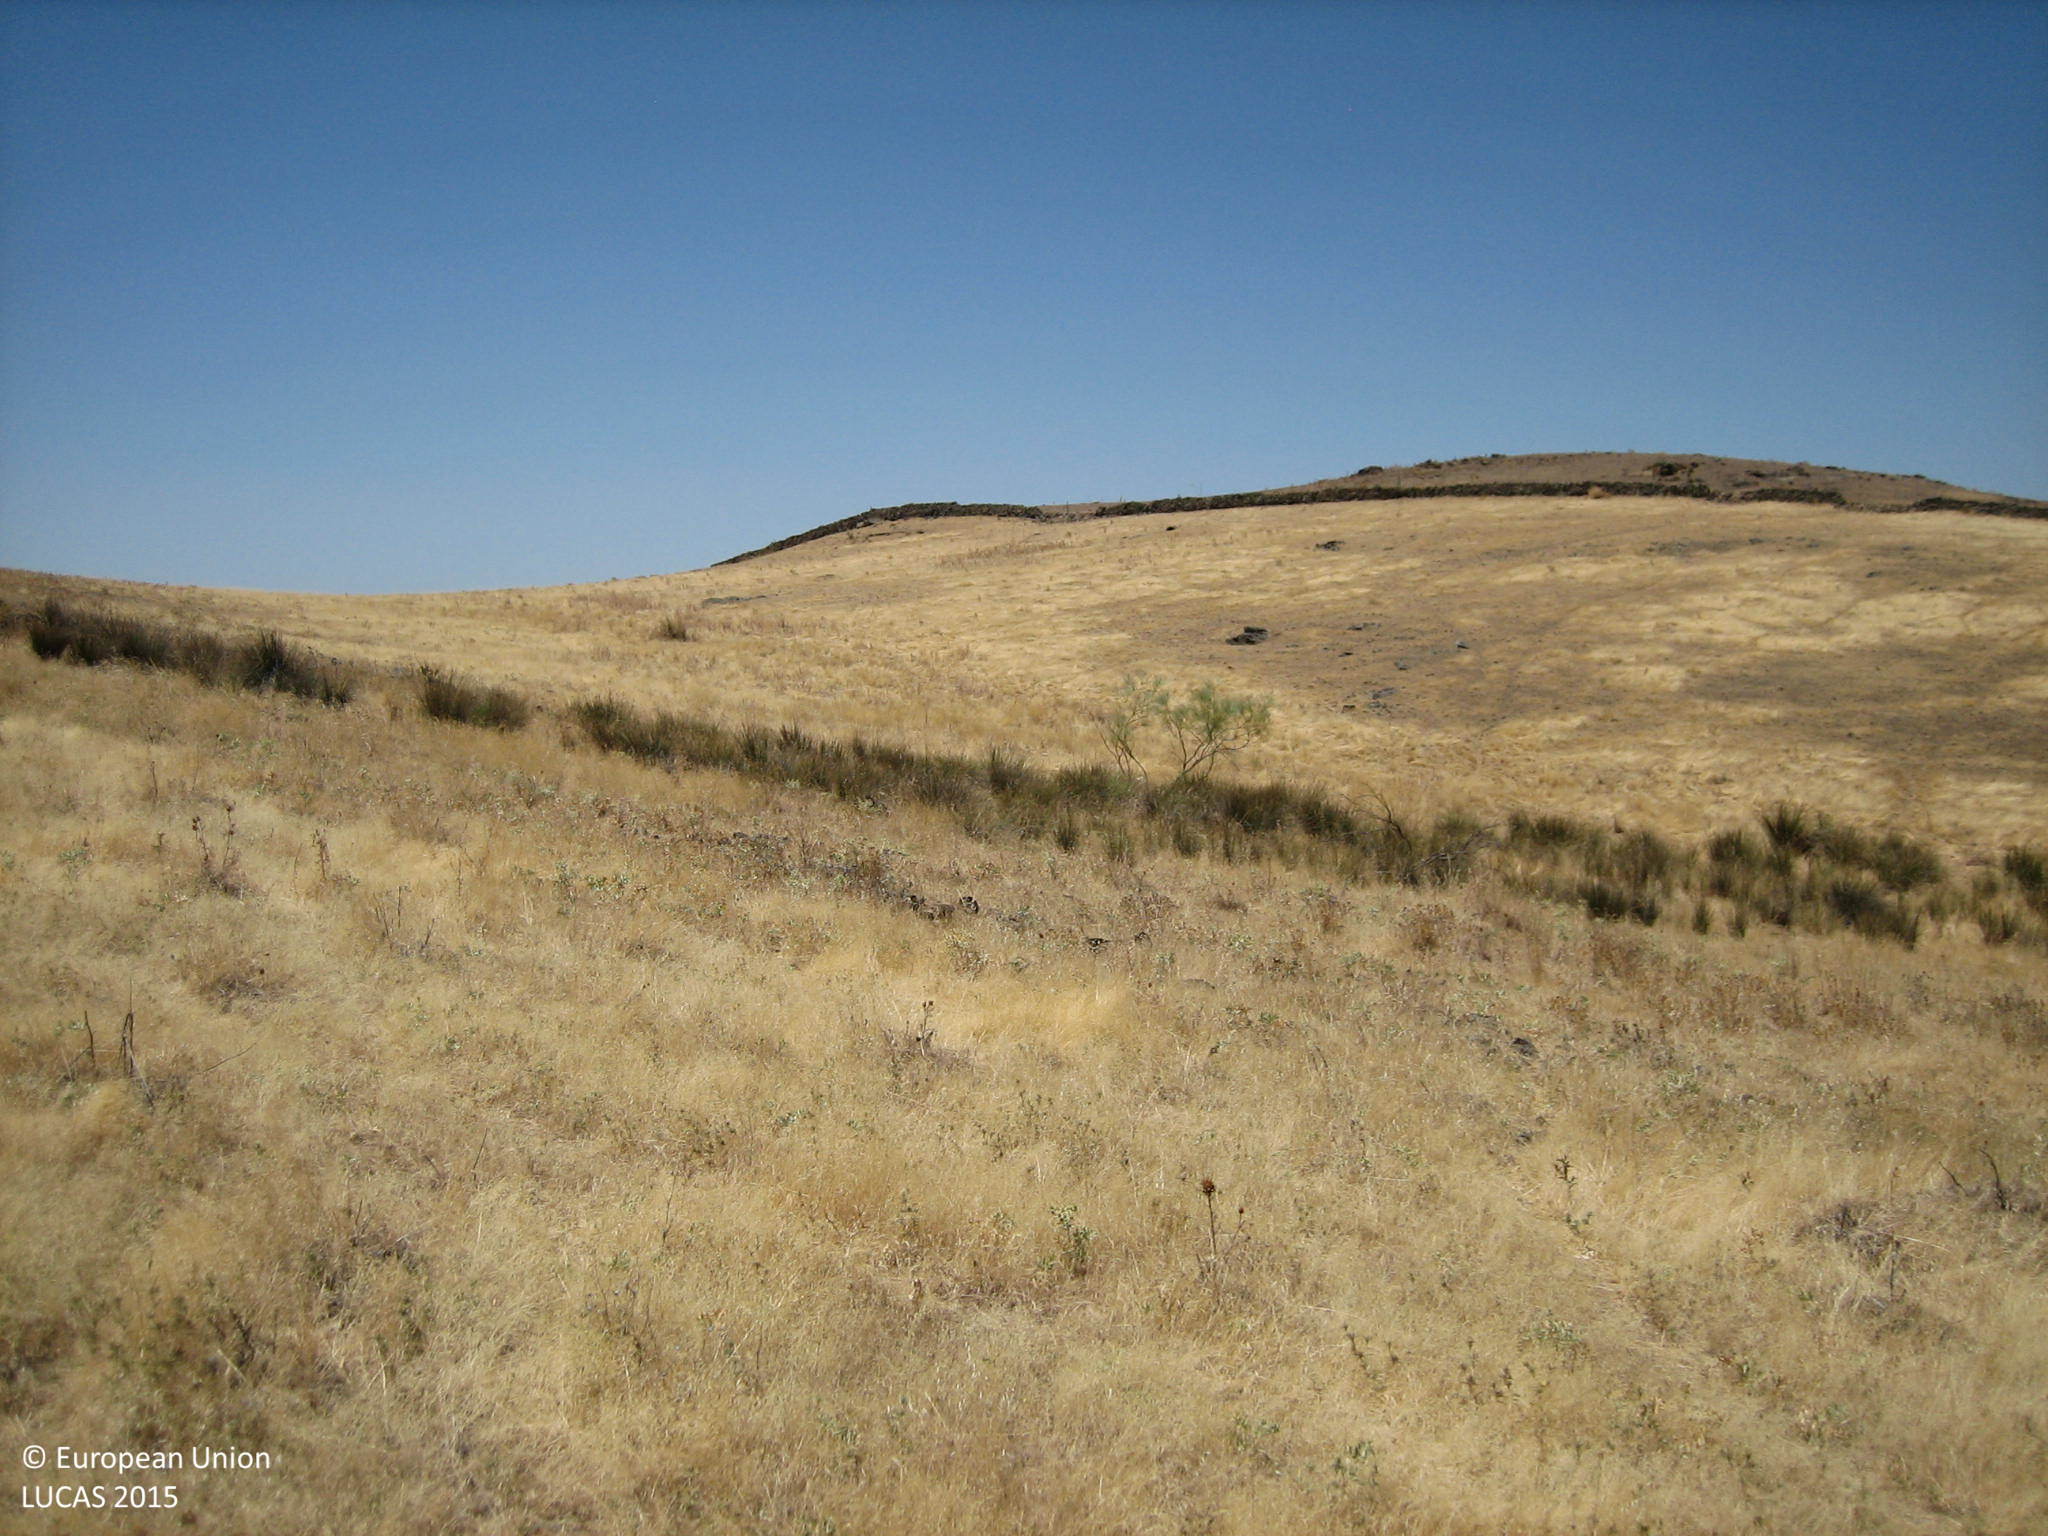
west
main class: Grassland
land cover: Grassland without tree/shrub cover
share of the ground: > 75 %
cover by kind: herbaceous plants 100 %
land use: Agriculture (excluding fallow land and kitchen gardens)
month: July
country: ES
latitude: 38.5301
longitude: -6.1645
